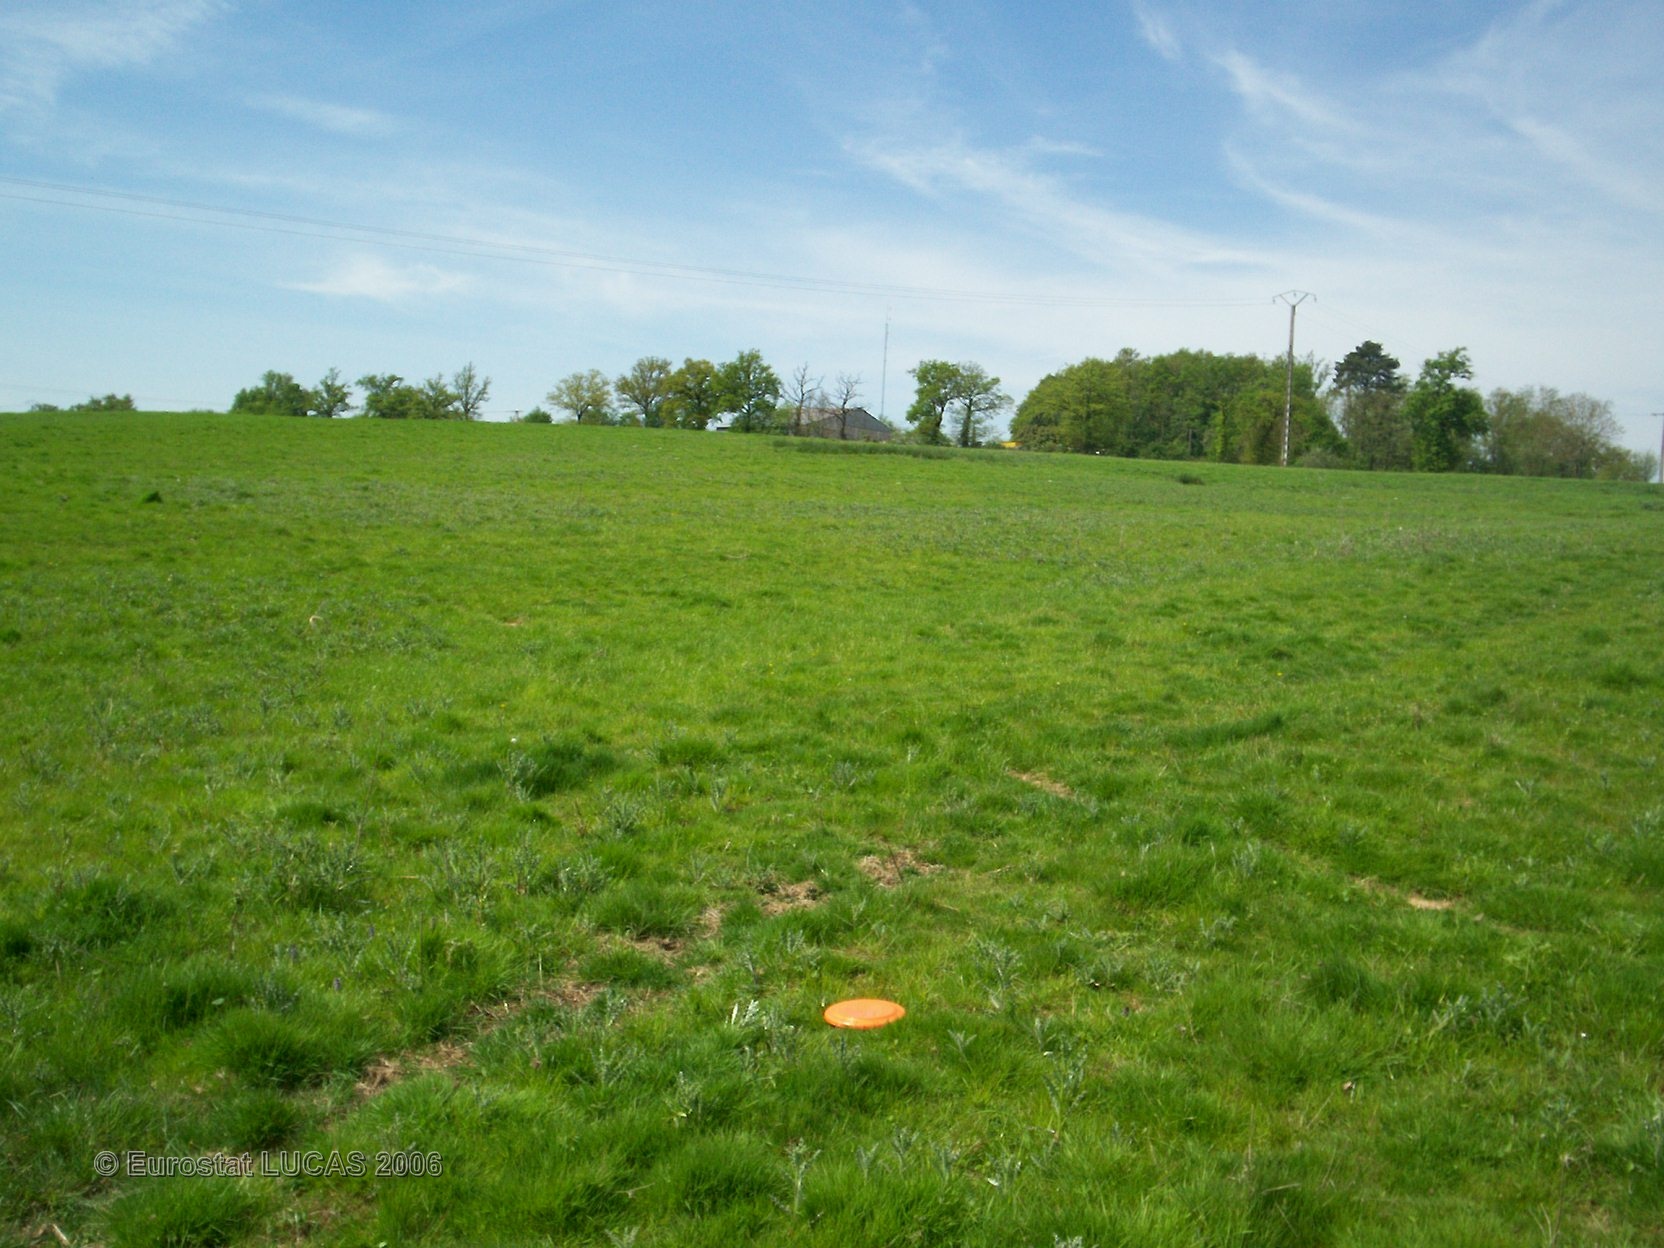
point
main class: Grassland
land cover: Grassland without tree/shrub cover
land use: Agriculture (excluding fallow land and kitchen gardens)
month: May
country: FR
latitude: 45.9976
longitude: 0.6766
